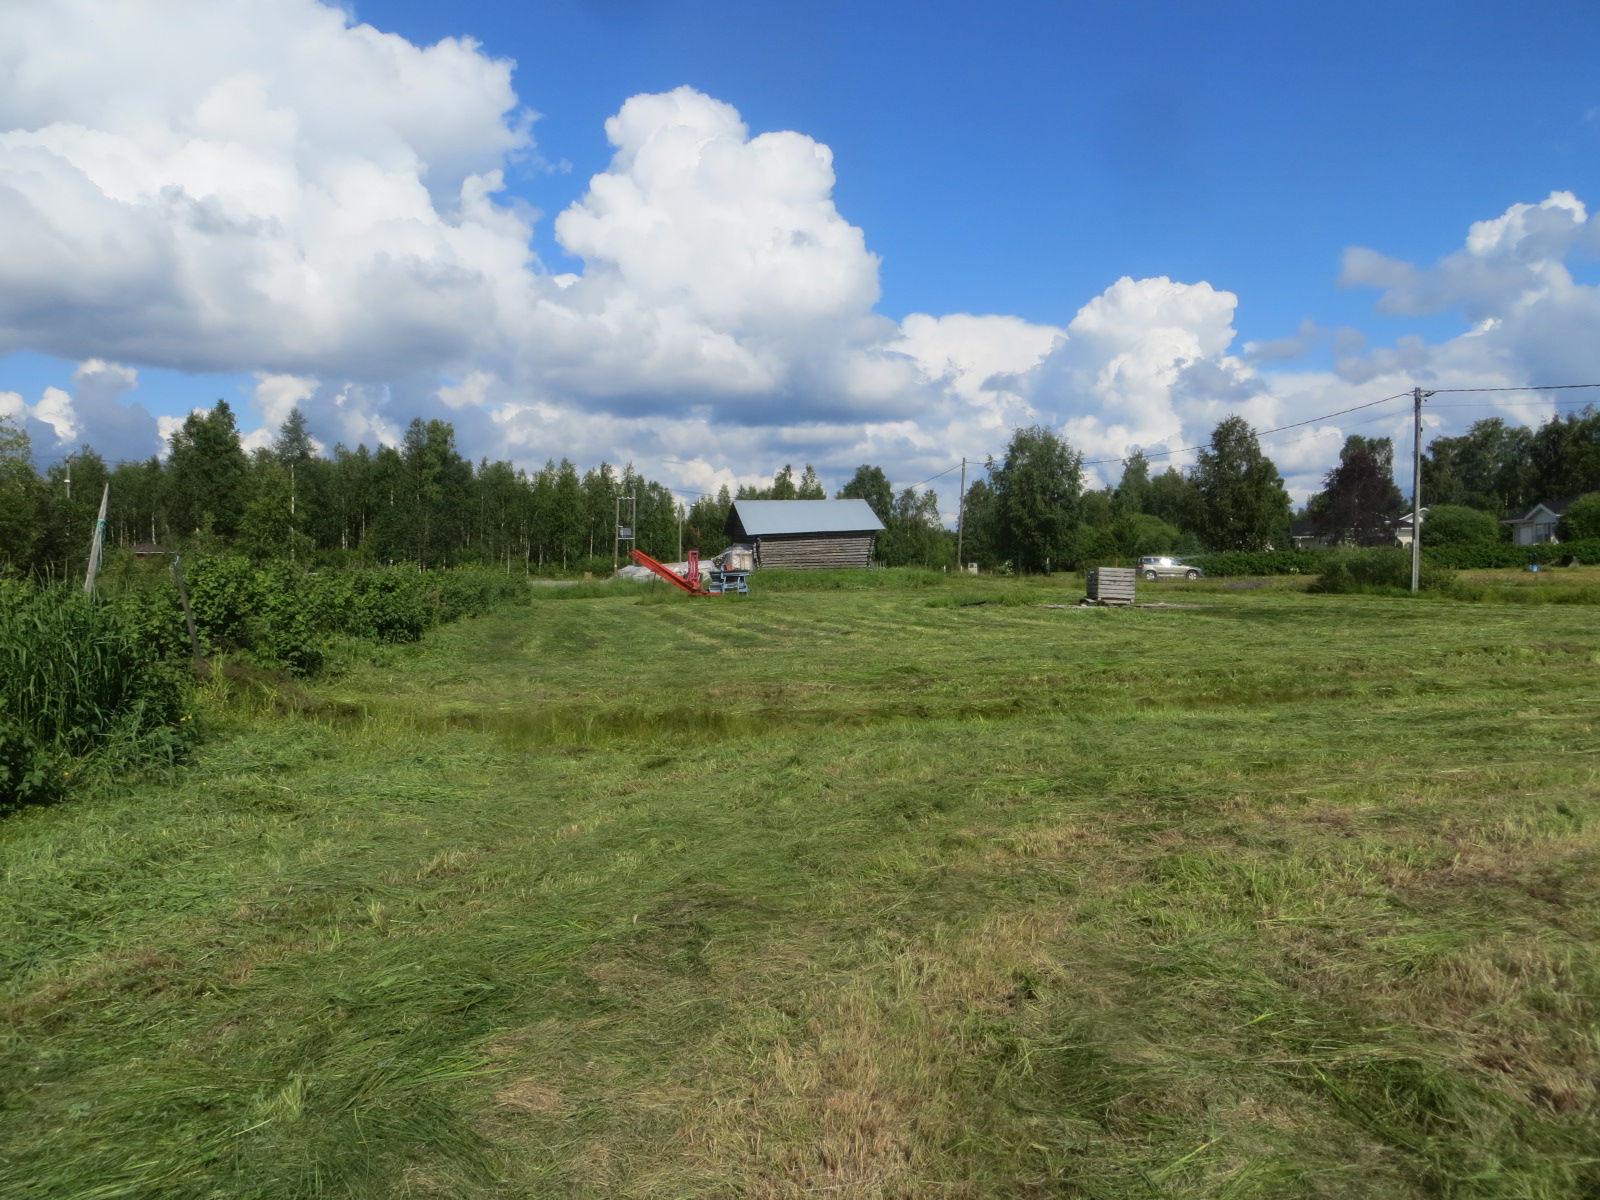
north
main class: Grassland
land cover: Grassland without tree/shrub cover
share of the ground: > 75 %
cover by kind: herbaceous plants 100 %
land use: Agriculture (excluding fallow land and kitchen gardens)
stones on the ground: < 10 %
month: July
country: FI
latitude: 66.4693
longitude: 25.6223
